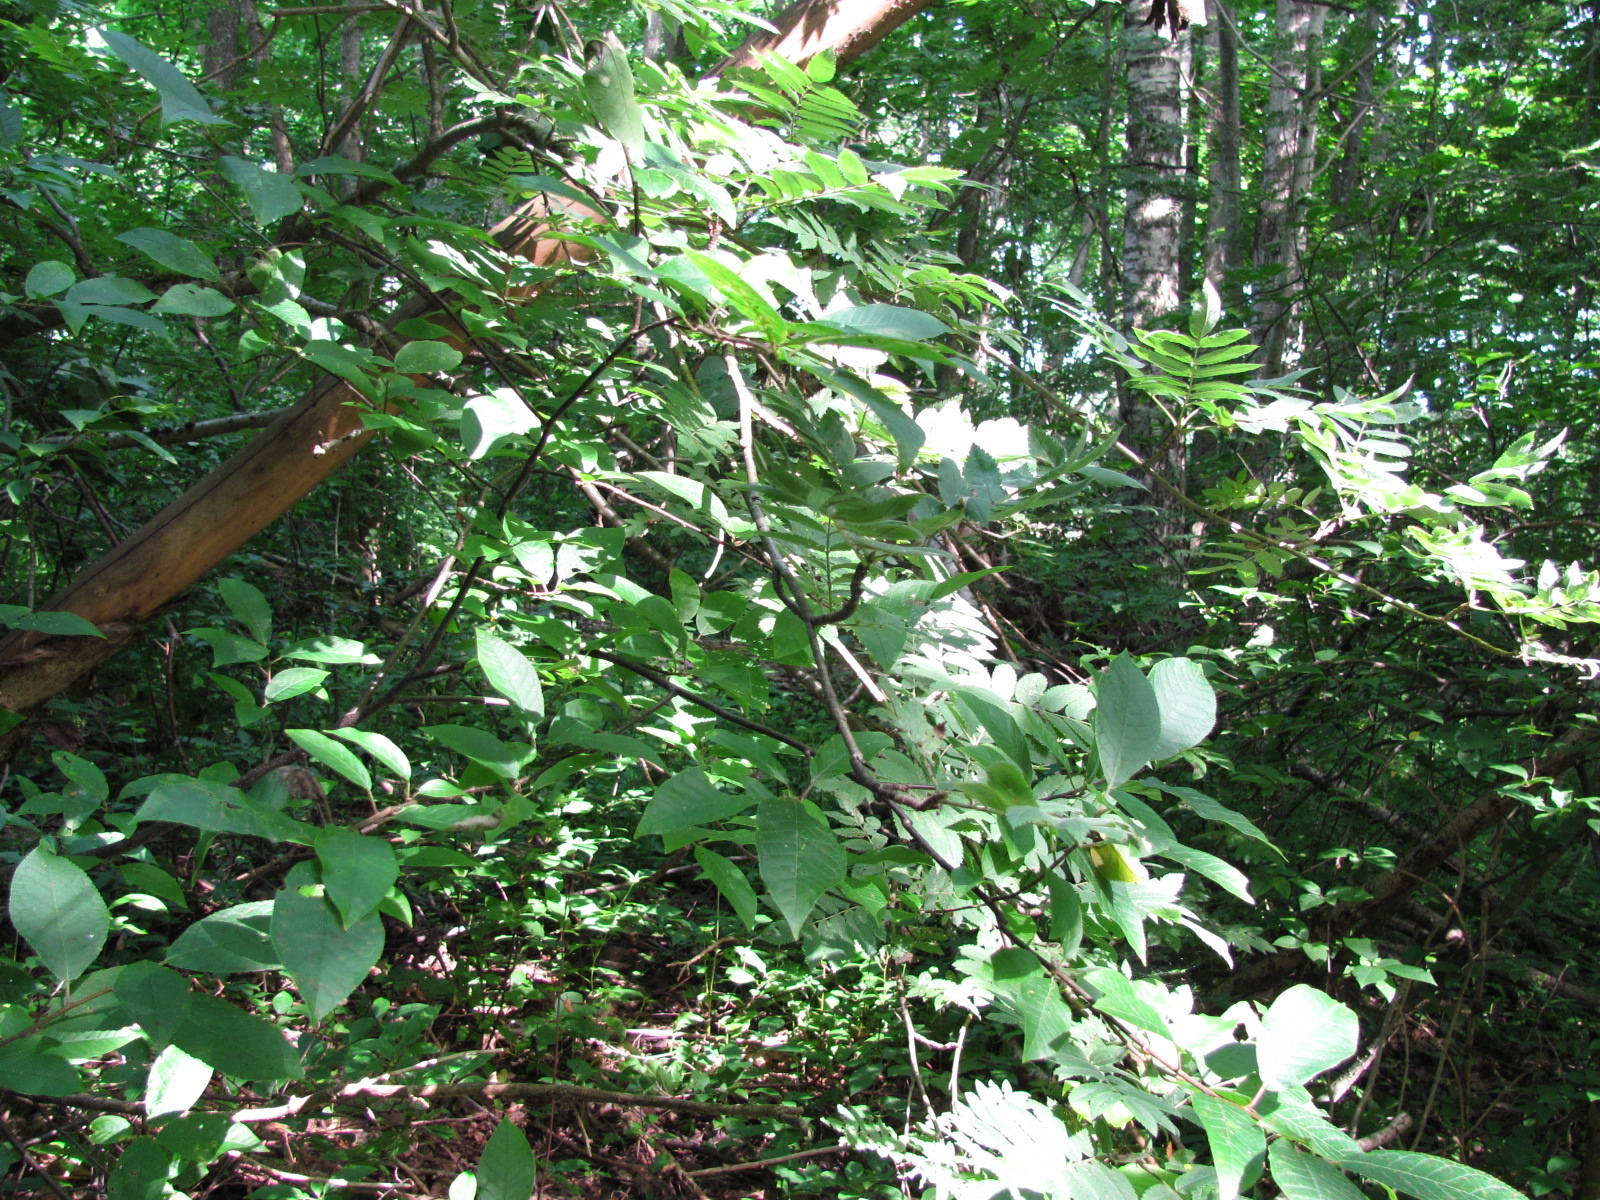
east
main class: Woodland
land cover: Broadleaved woodland
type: non-riverine alder, birch or aspen forest
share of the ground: > 75 %
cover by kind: broadleaved forest trees 90 %, herbaceous plants 10 %
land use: Forestry
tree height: > 5 m
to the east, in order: Broadleaved woodland; Barley; Electric lines; Barley; Broadleaved woodland
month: July
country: LV
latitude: 56.3558
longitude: 24.4175
